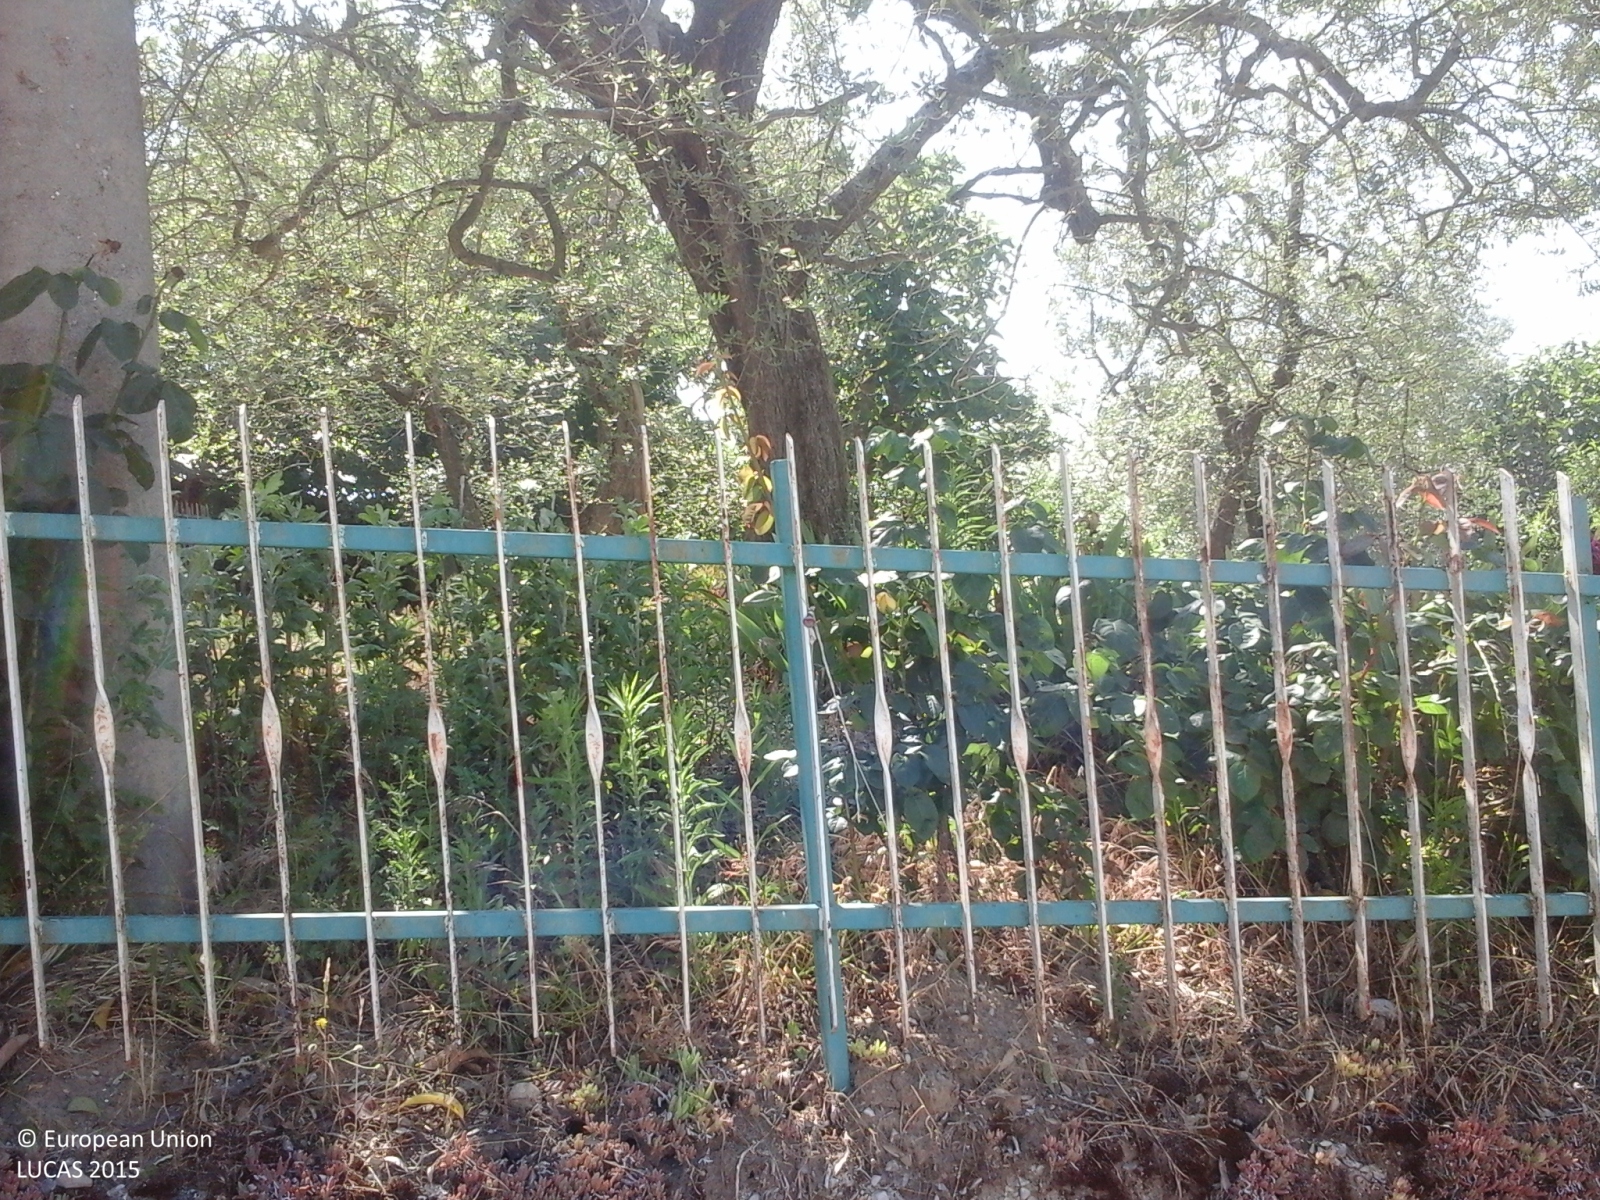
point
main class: Cropland
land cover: Olive groves
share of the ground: 50 - 75 %
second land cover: Spontaneously vegetated surfaces
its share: 10 - 25 %
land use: Agriculture (excluding fallow land and kitchen gardens)
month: June
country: IT
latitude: 41.1139
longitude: 15.0901
